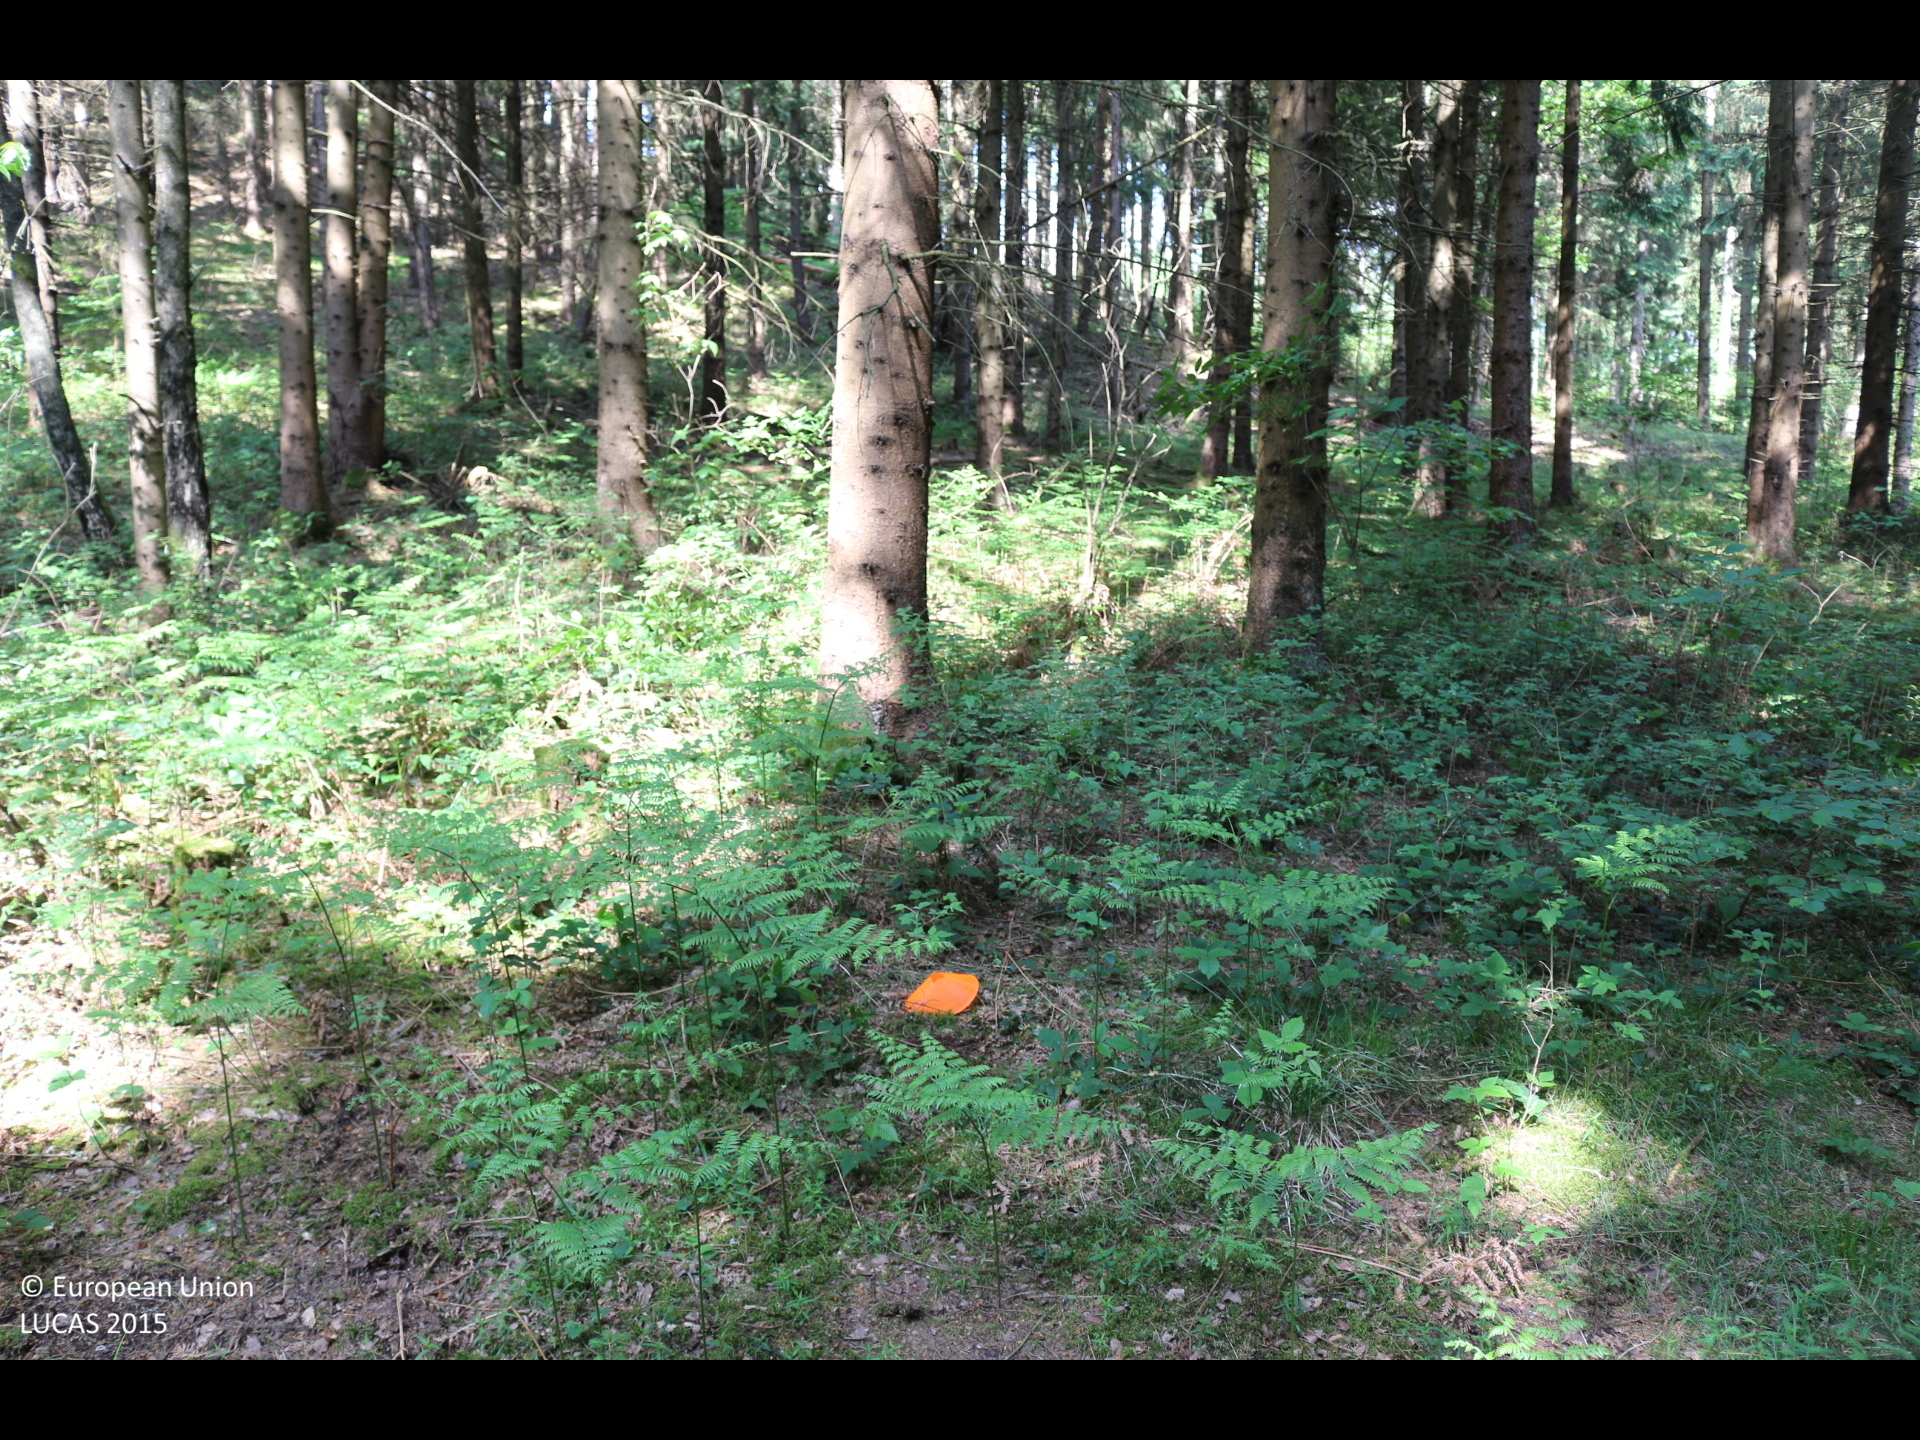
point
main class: Woodland
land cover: Spruce dominated coniferous woodland
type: alpine coniferous forest
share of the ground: > 75 %
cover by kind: coniferous forest trees 95 %, broadleaved forest trees 5 %
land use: Forestry
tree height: > 5 m
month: May
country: AT
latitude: 46.7685
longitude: 14.3321
